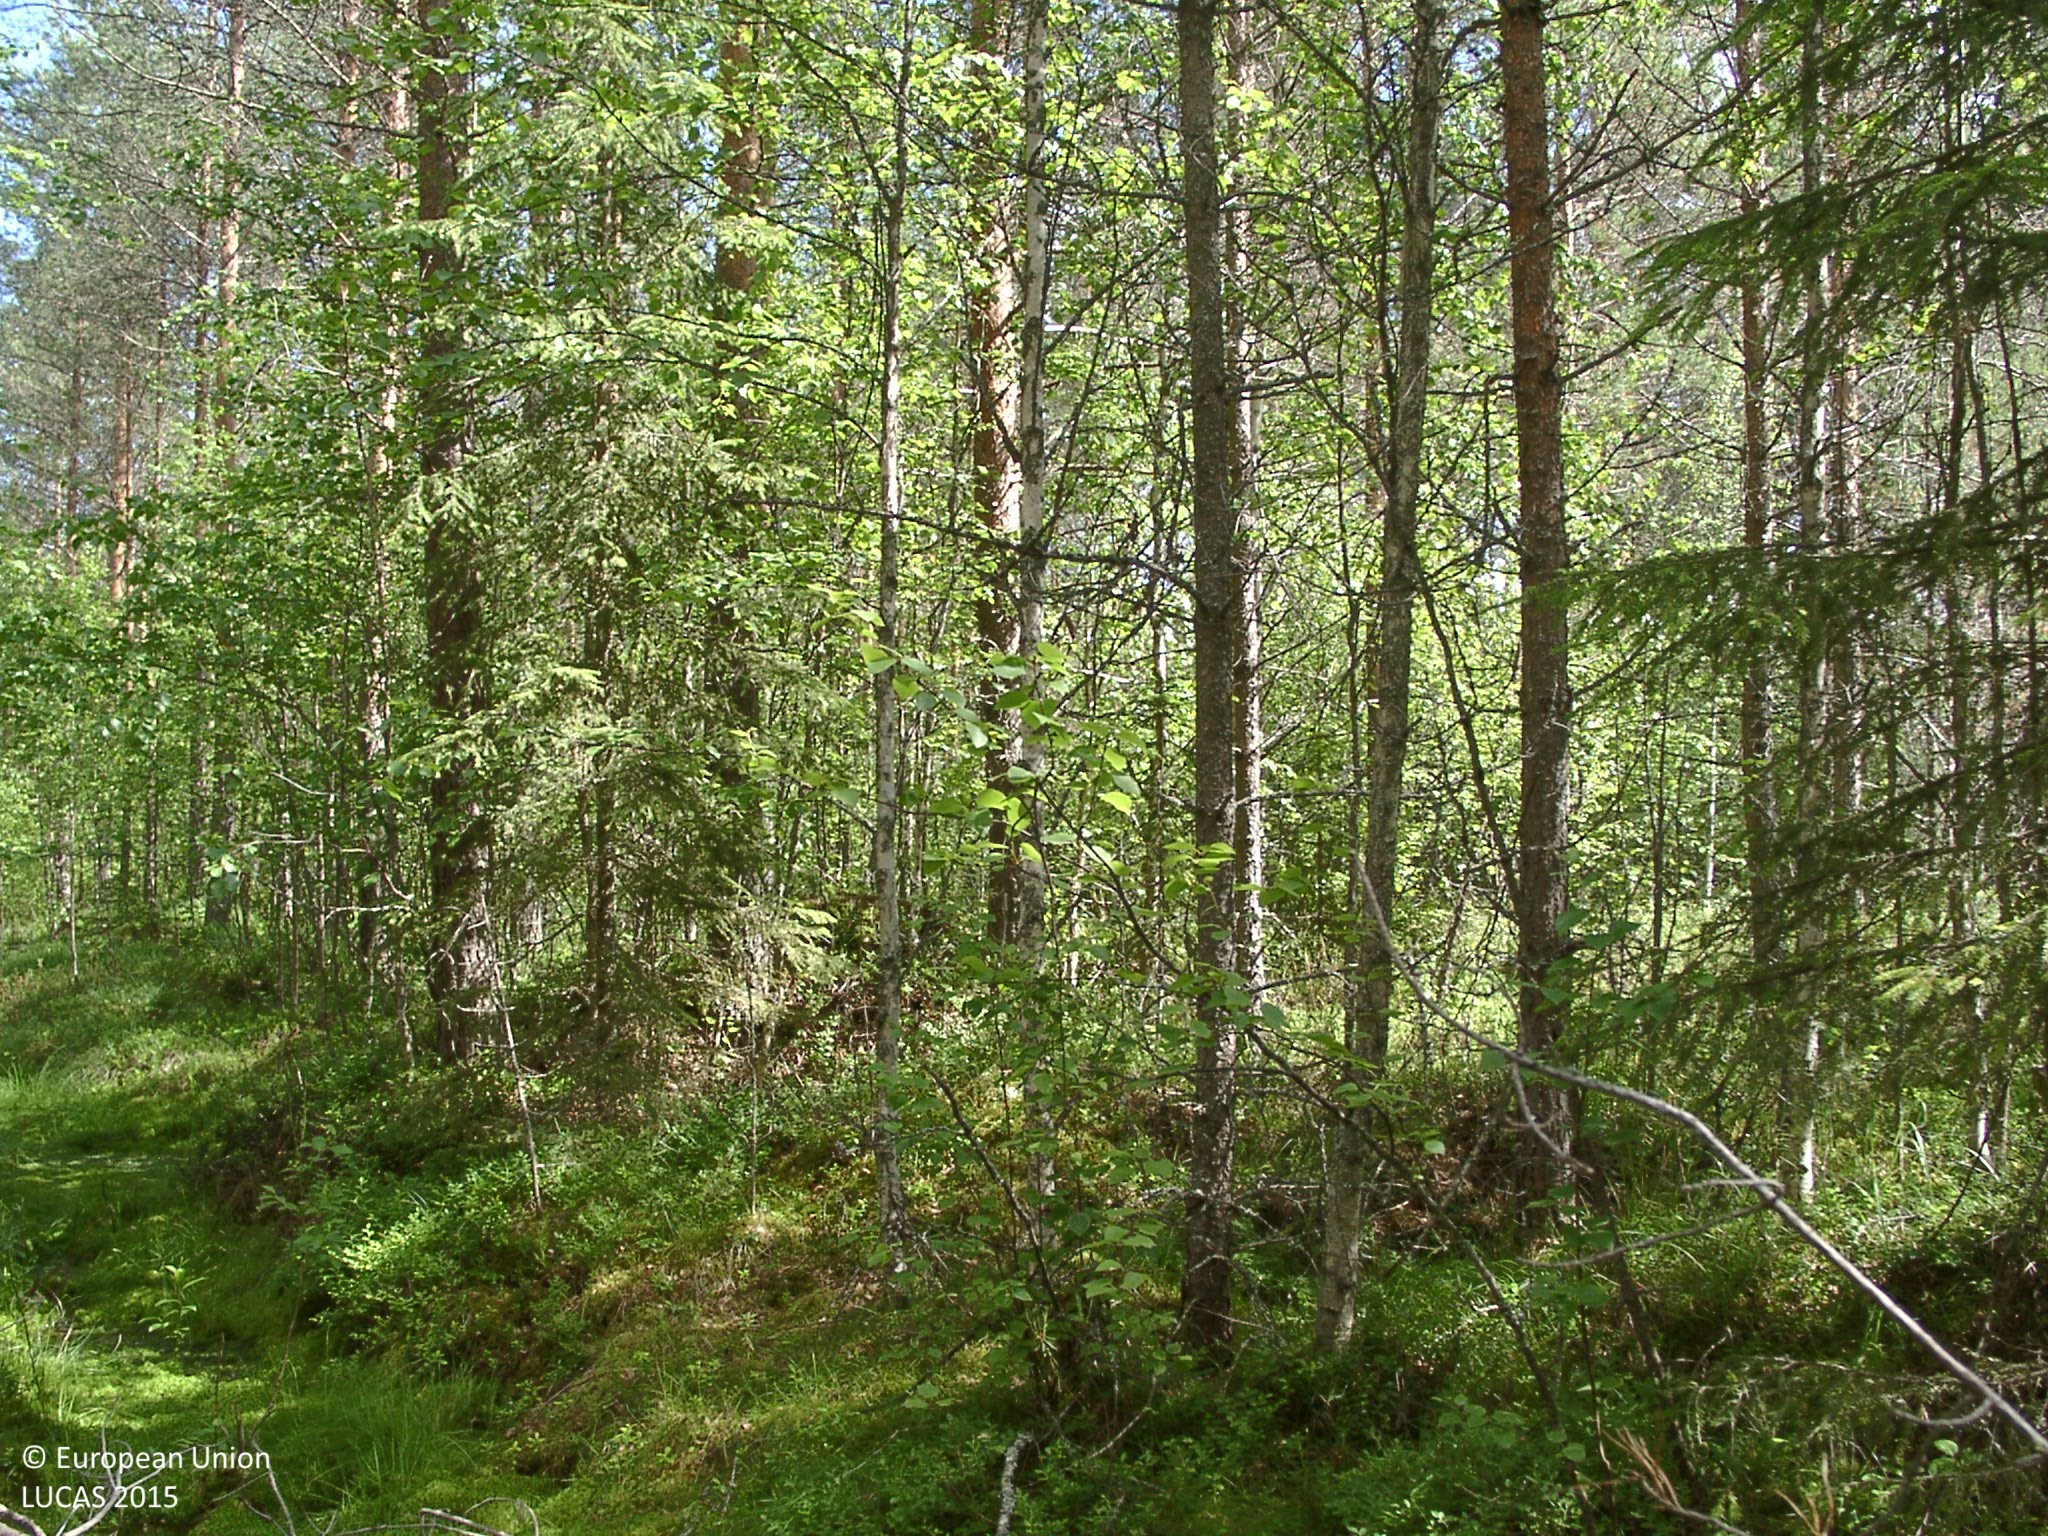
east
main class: Woodland
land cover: Pine dominated coniferous woodland
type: mire and swamp forests
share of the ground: 50 - 75 %
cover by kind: coniferous forest trees 50 %, shrubs 30 %, broadleaved forest trees 15 %, lichens and mosses 5 %
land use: Forestry
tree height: > 5 m
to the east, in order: Ditches and canals; Pine dominated mixed woodland; Shruby margins; Pine dominated coniferous woodland; Shruby margins; Pine dominated coniferous woodland; Ditches and canals; Shruby margins; Tracks; Shruby margins; Ditches and canals; Pine dominated mixed woodland; Ditches and canals; Pine dominated mixed woodland; Ditches and canals; Other mixed woodland
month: July
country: FI
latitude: 62.2785
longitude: 24.9979
